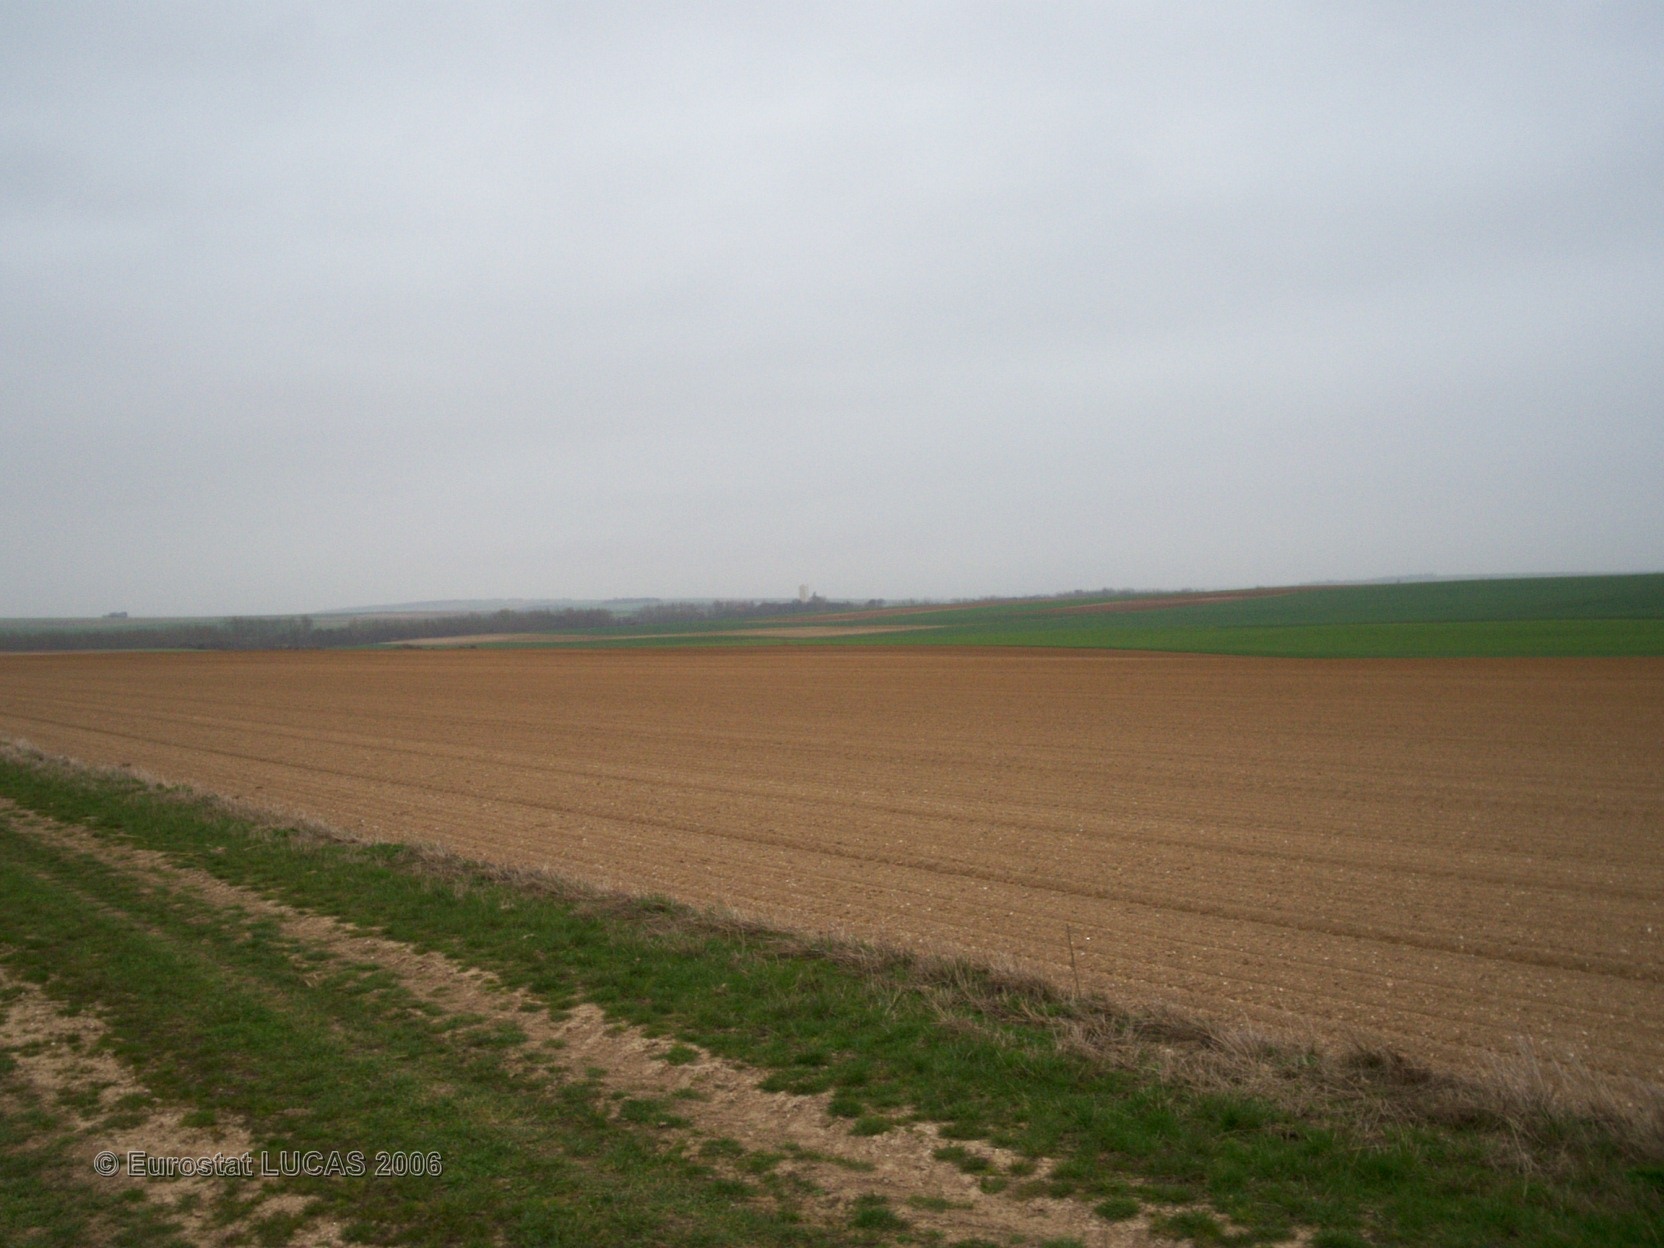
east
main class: Cropland
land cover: Dry pulses
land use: Agriculture (excluding fallow land and kitchen gardens)
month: April
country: FR
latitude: 49.2523
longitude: 4.3770
